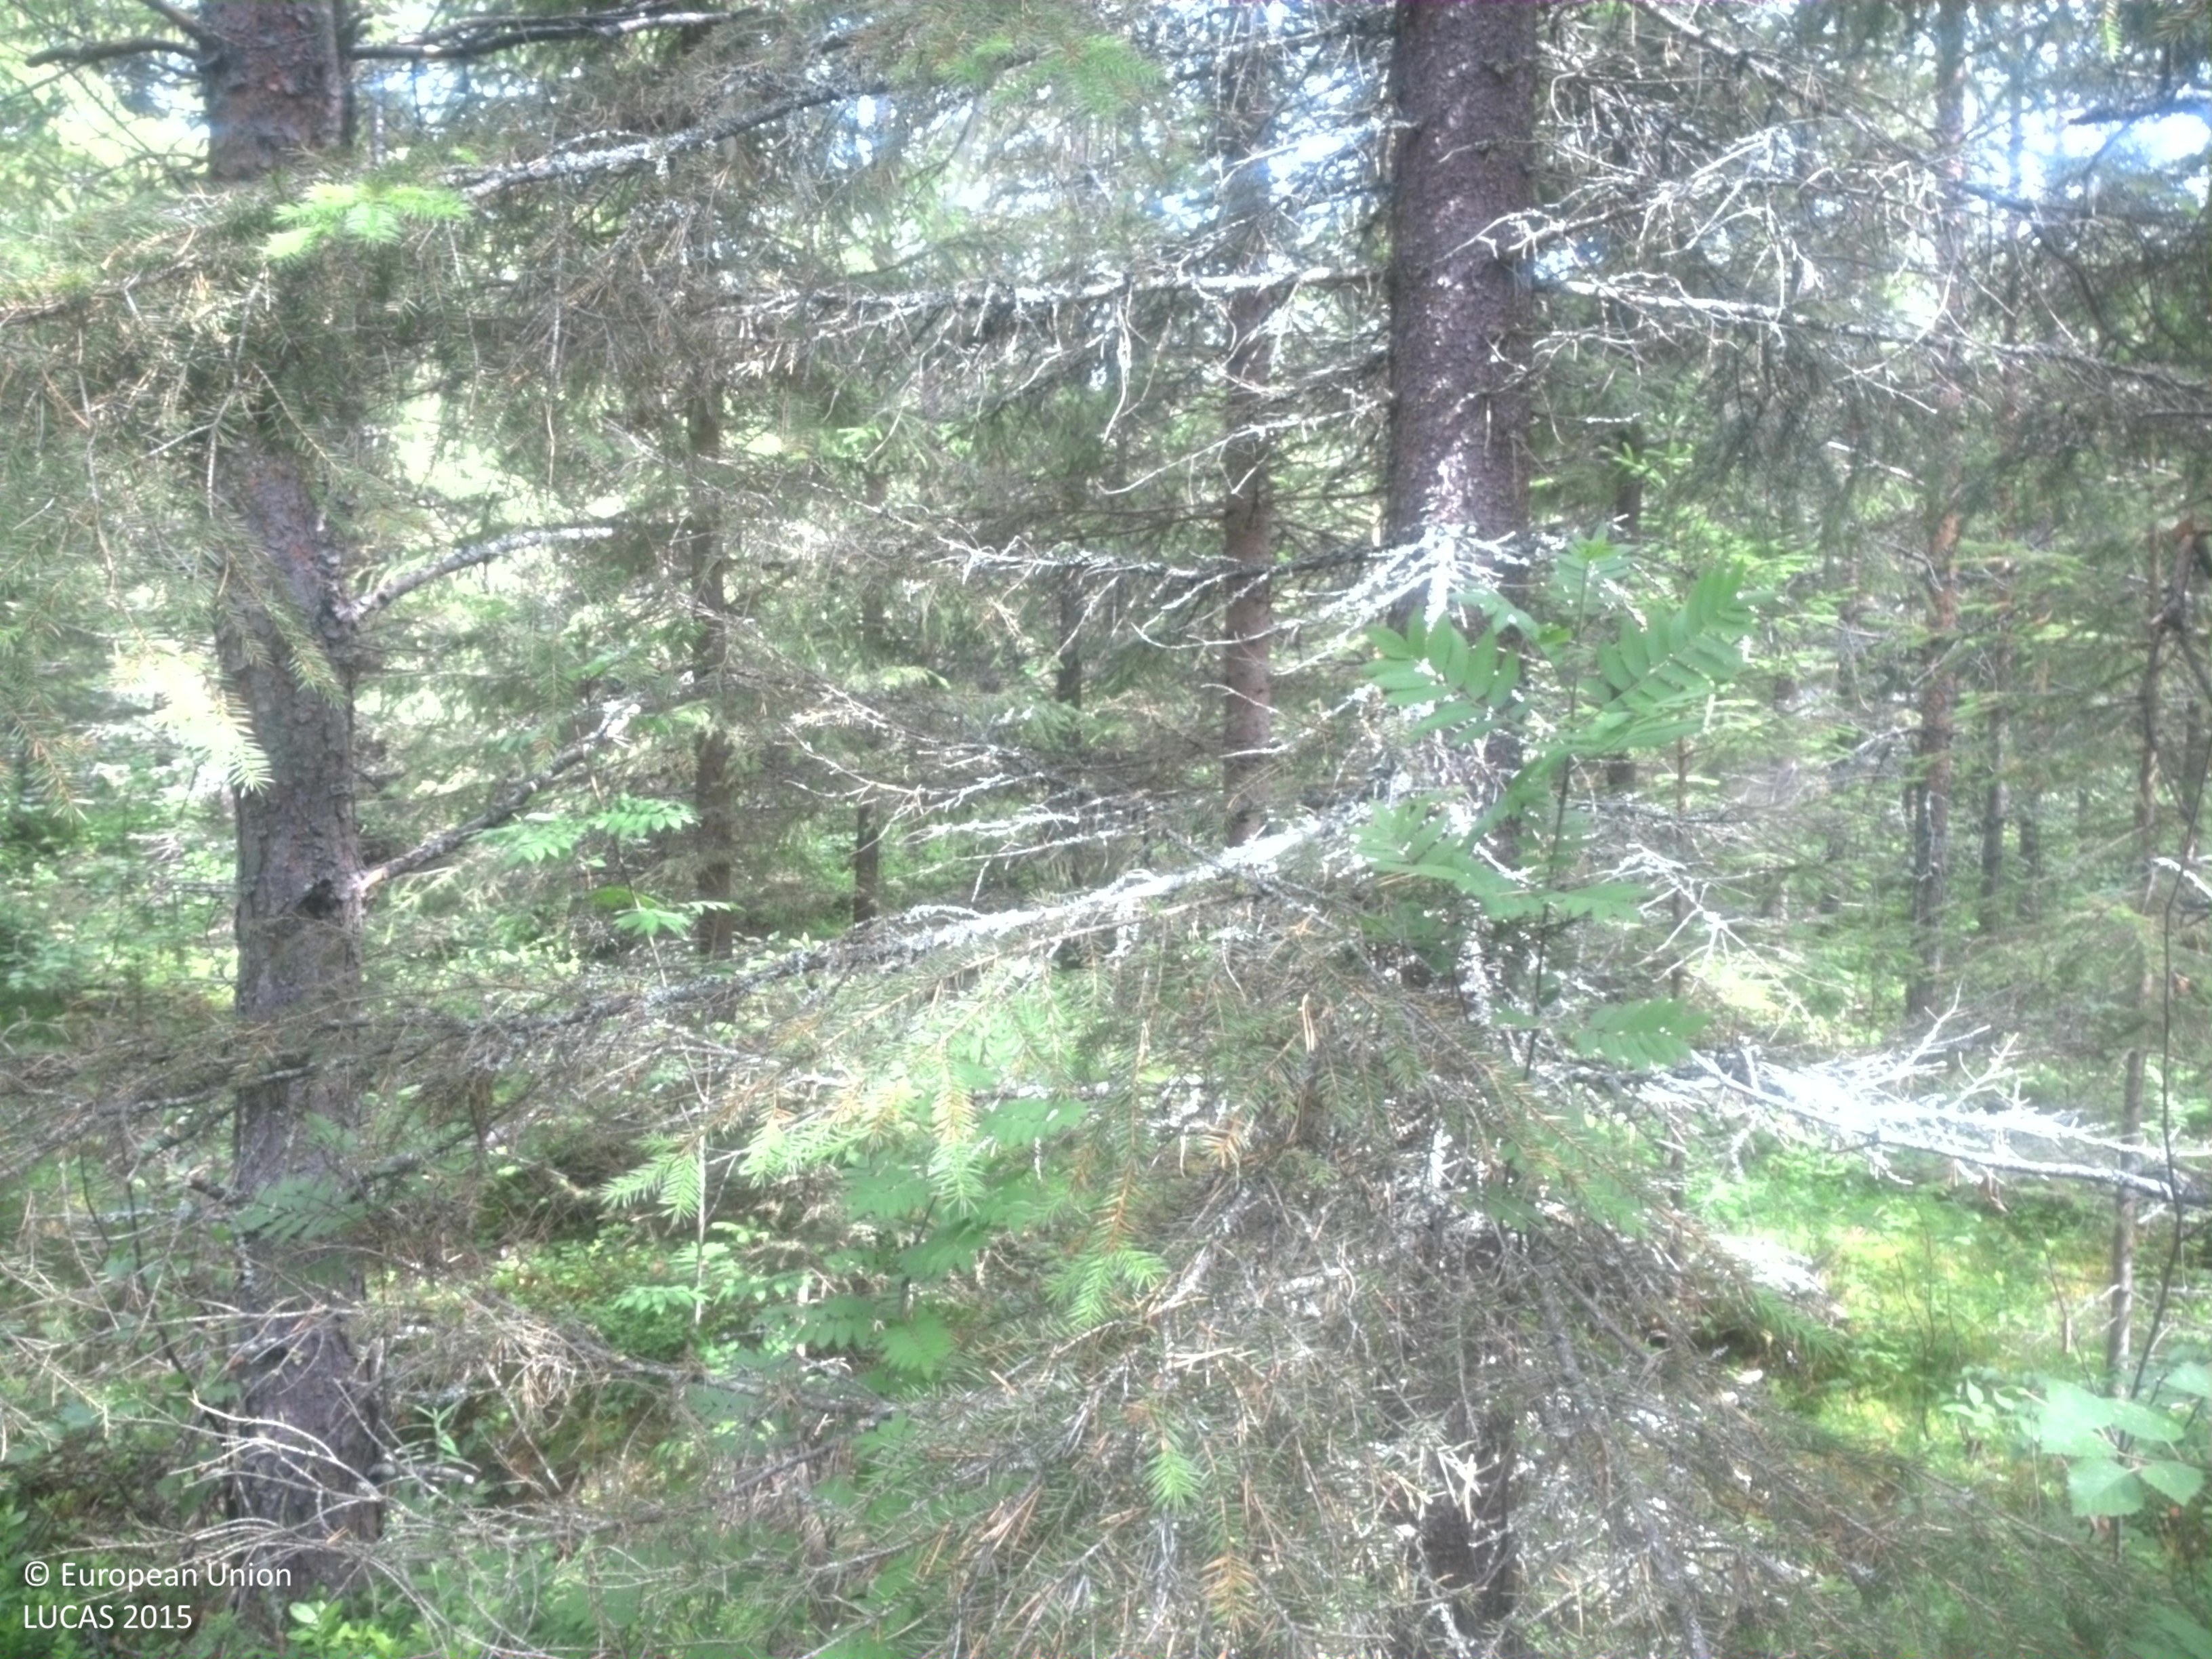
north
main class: Woodland
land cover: Other coniferous woodland
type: boreal forest
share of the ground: > 75 %
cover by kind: coniferous forest trees 80 %, shrubs 15 %, broadleaved forest trees 5 %
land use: Forestry
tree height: > 5 m
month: July
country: SE
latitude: 64.5361
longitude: 20.5880
